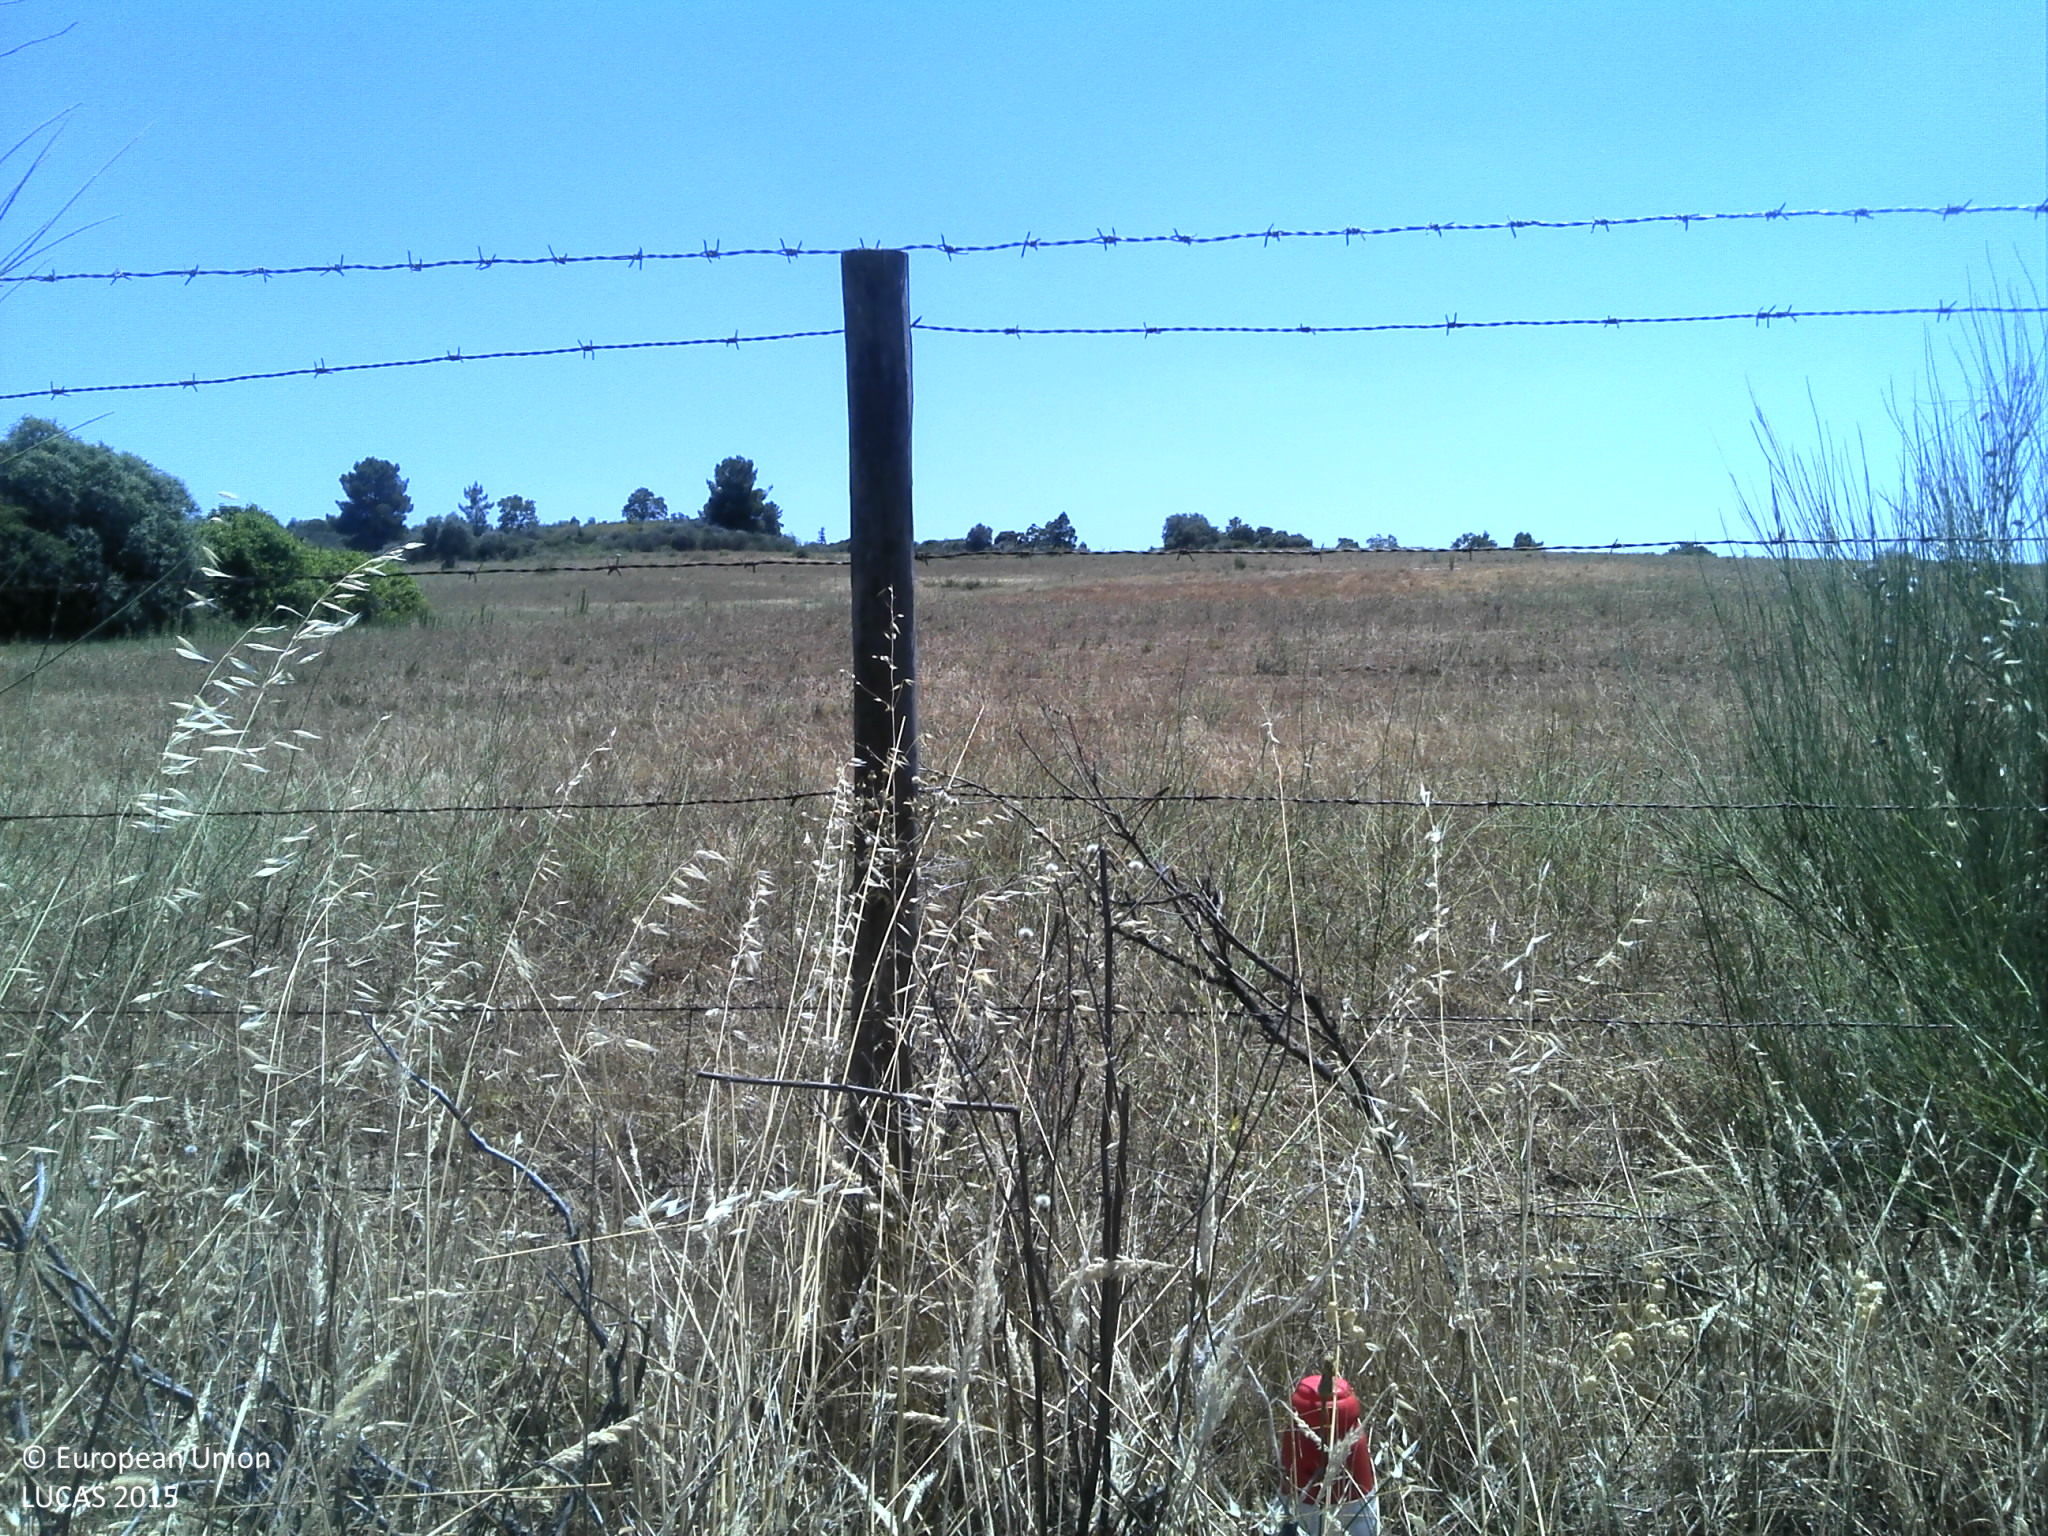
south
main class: Grassland
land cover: Grassland without tree/shrub cover
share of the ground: 50 - 75 %
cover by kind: herbaceous plants 65 %, unconsolidated bare surface 30 %
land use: Agriculture (excluding fallow land and kitchen gardens)
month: June
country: PT
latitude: 40.1119
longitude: -7.2391
